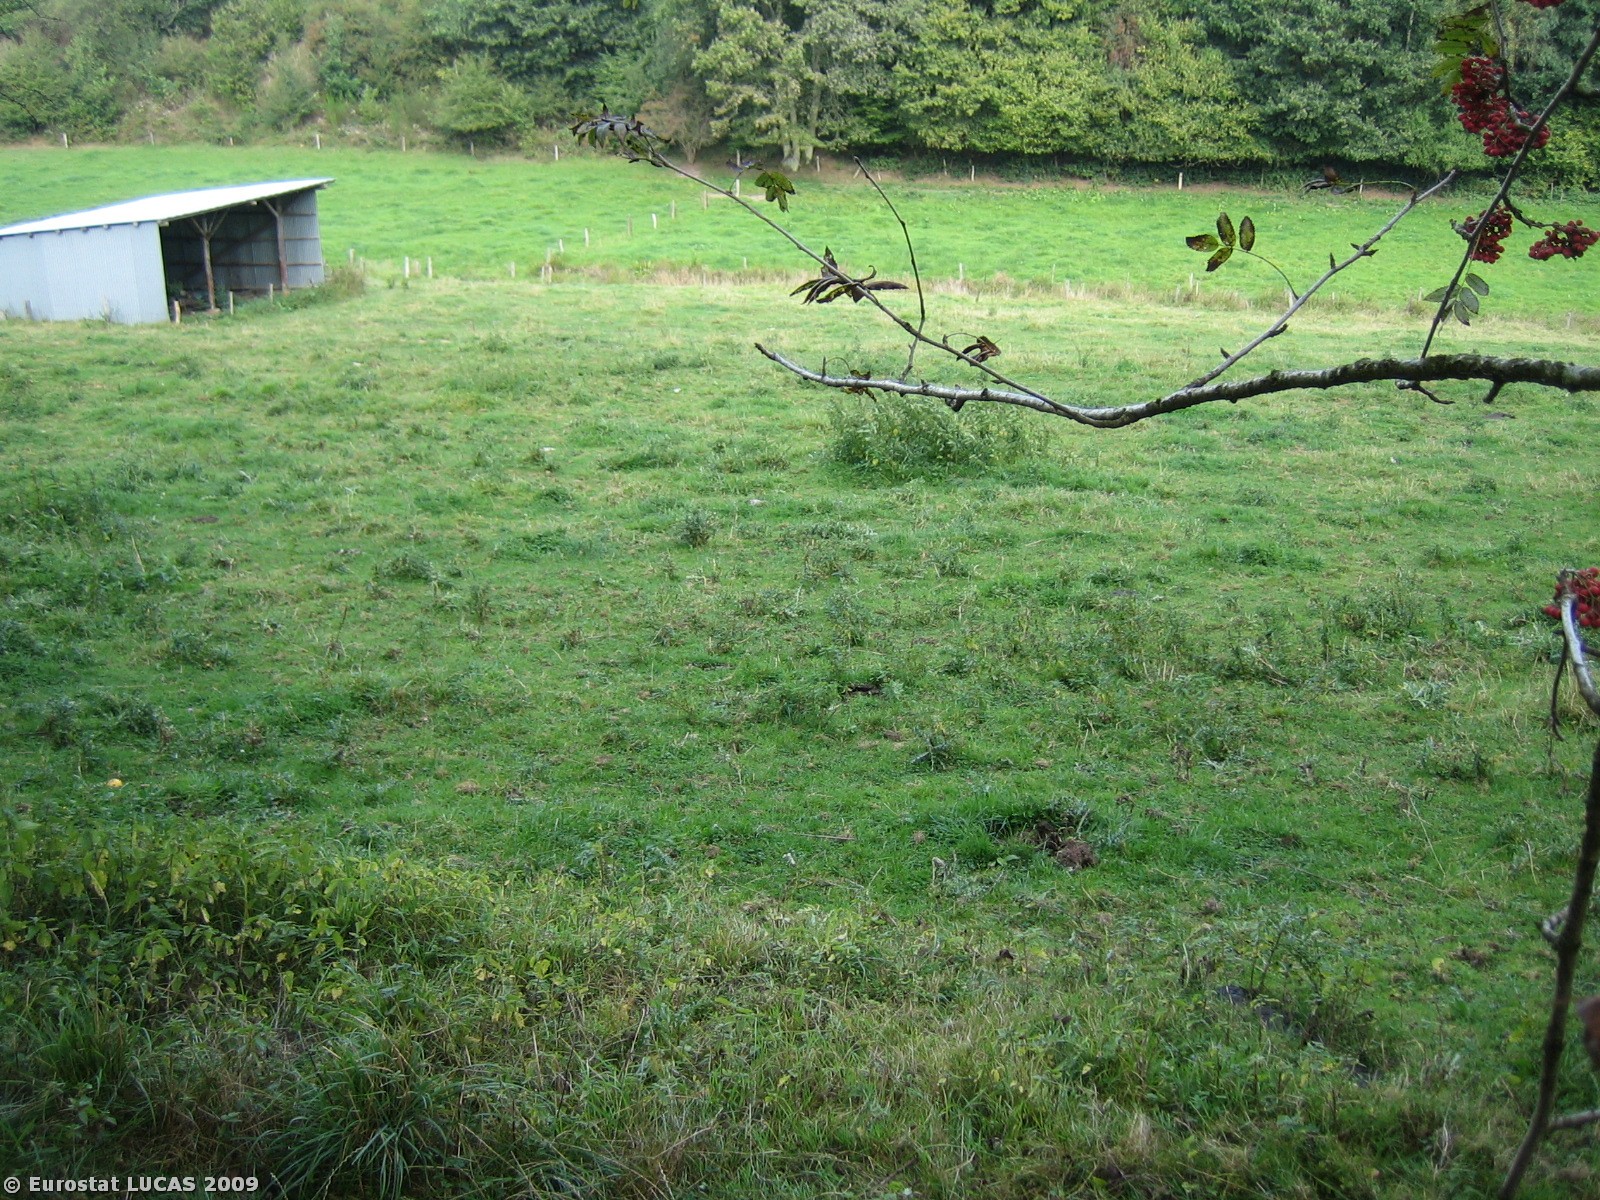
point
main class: Grassland
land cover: Grassland without tree/shrub cover
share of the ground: > 75 %
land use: Agriculture (excluding fallow land and kitchen gardens)
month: September
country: BE
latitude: 50.1182
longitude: 5.6210
